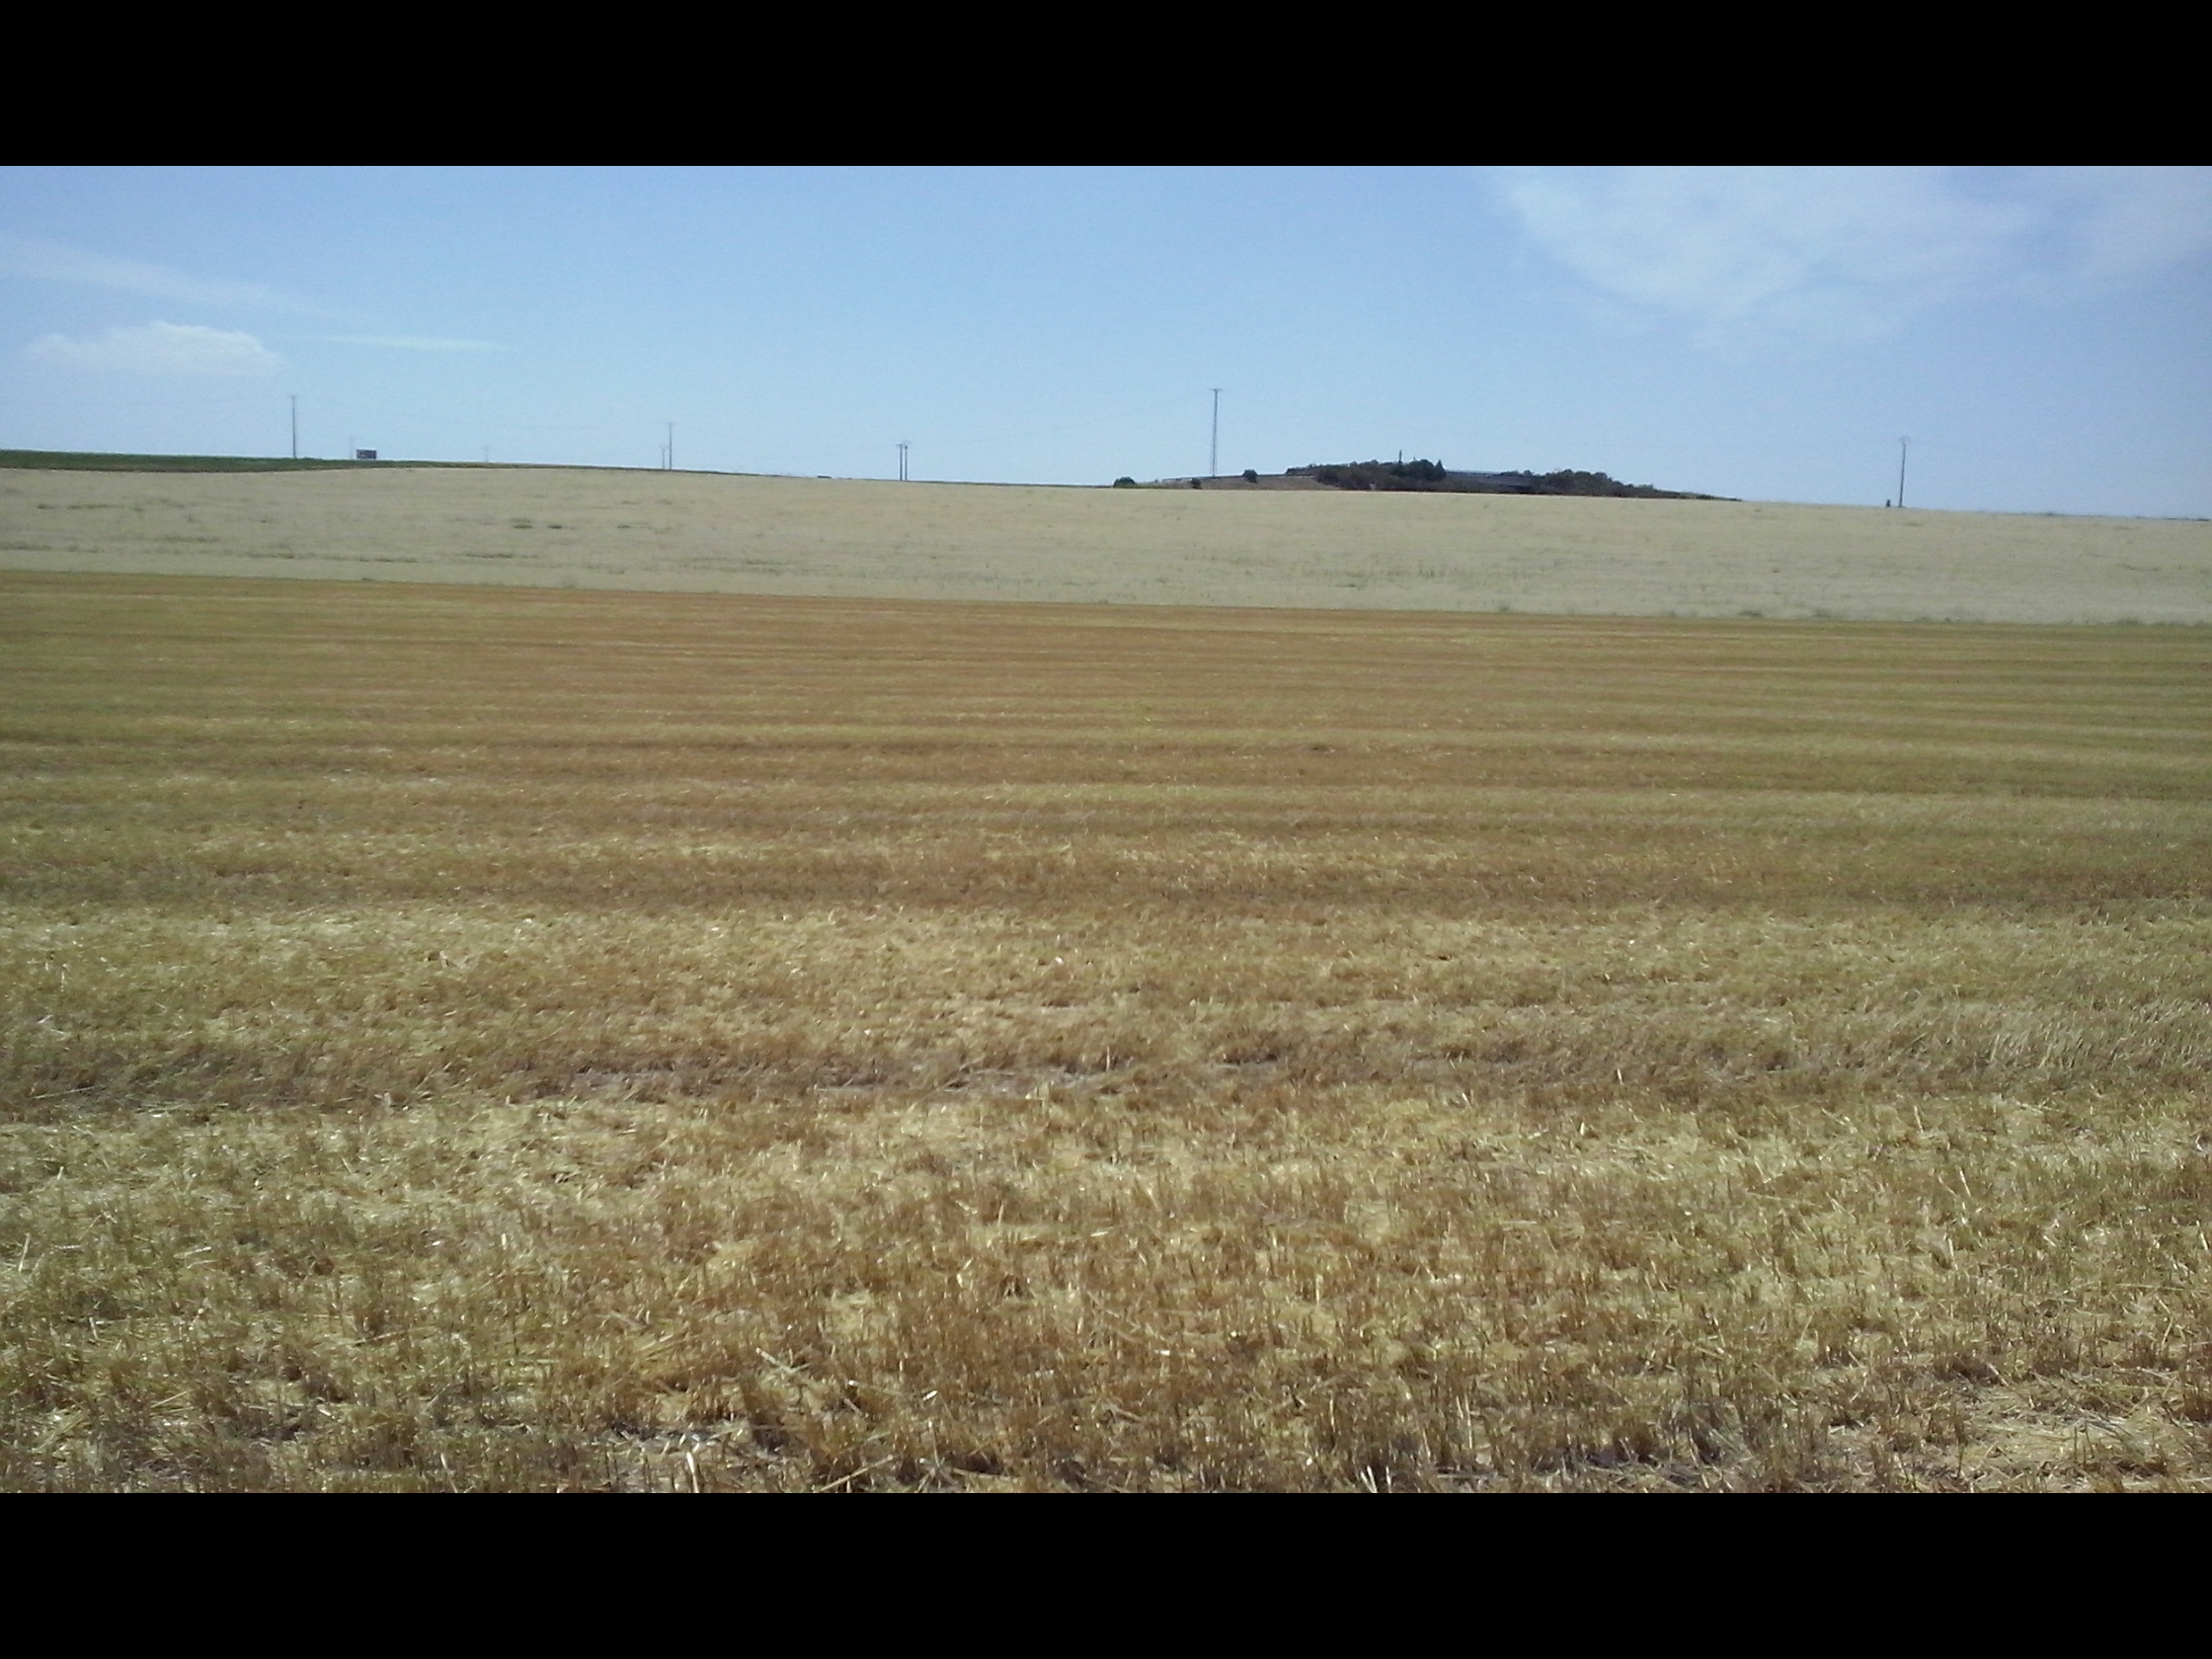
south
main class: Cropland
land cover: Barley
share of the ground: < 10 %
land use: Agriculture (excluding fallow land and kitchen gardens)
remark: Harvested field
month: July
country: ES
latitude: 41.5870
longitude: -5.1055
